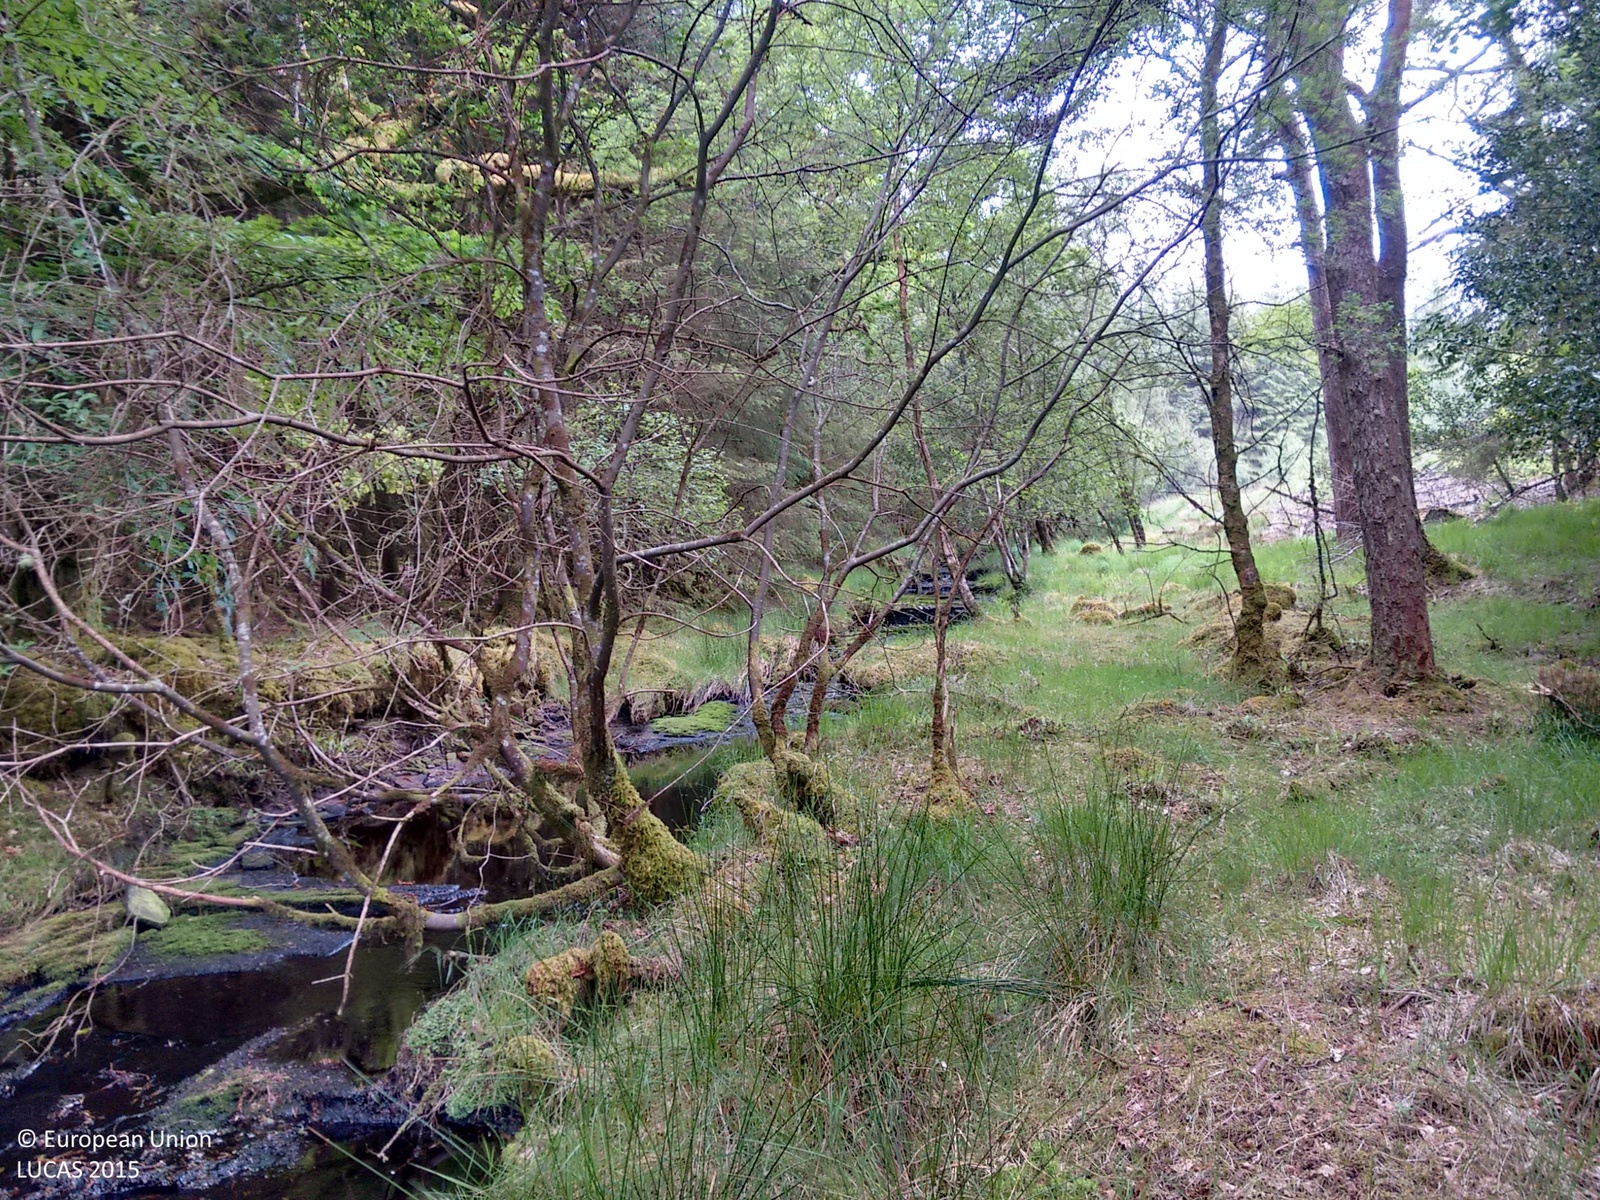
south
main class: Woodland
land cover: Spruce dominated mixed woodland
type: hemiboreal forest and nemoral coniferous forest and mixed broadleaved-coniferous forest
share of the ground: > 75 %
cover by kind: coniferous forest trees 50 %, broadleaved forest trees 25 %, lichens and mosses 15 %, herbaceous plants 5 %
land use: Forestry
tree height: > 5 m
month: June
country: IE
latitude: 53.0355
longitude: -8.4605
